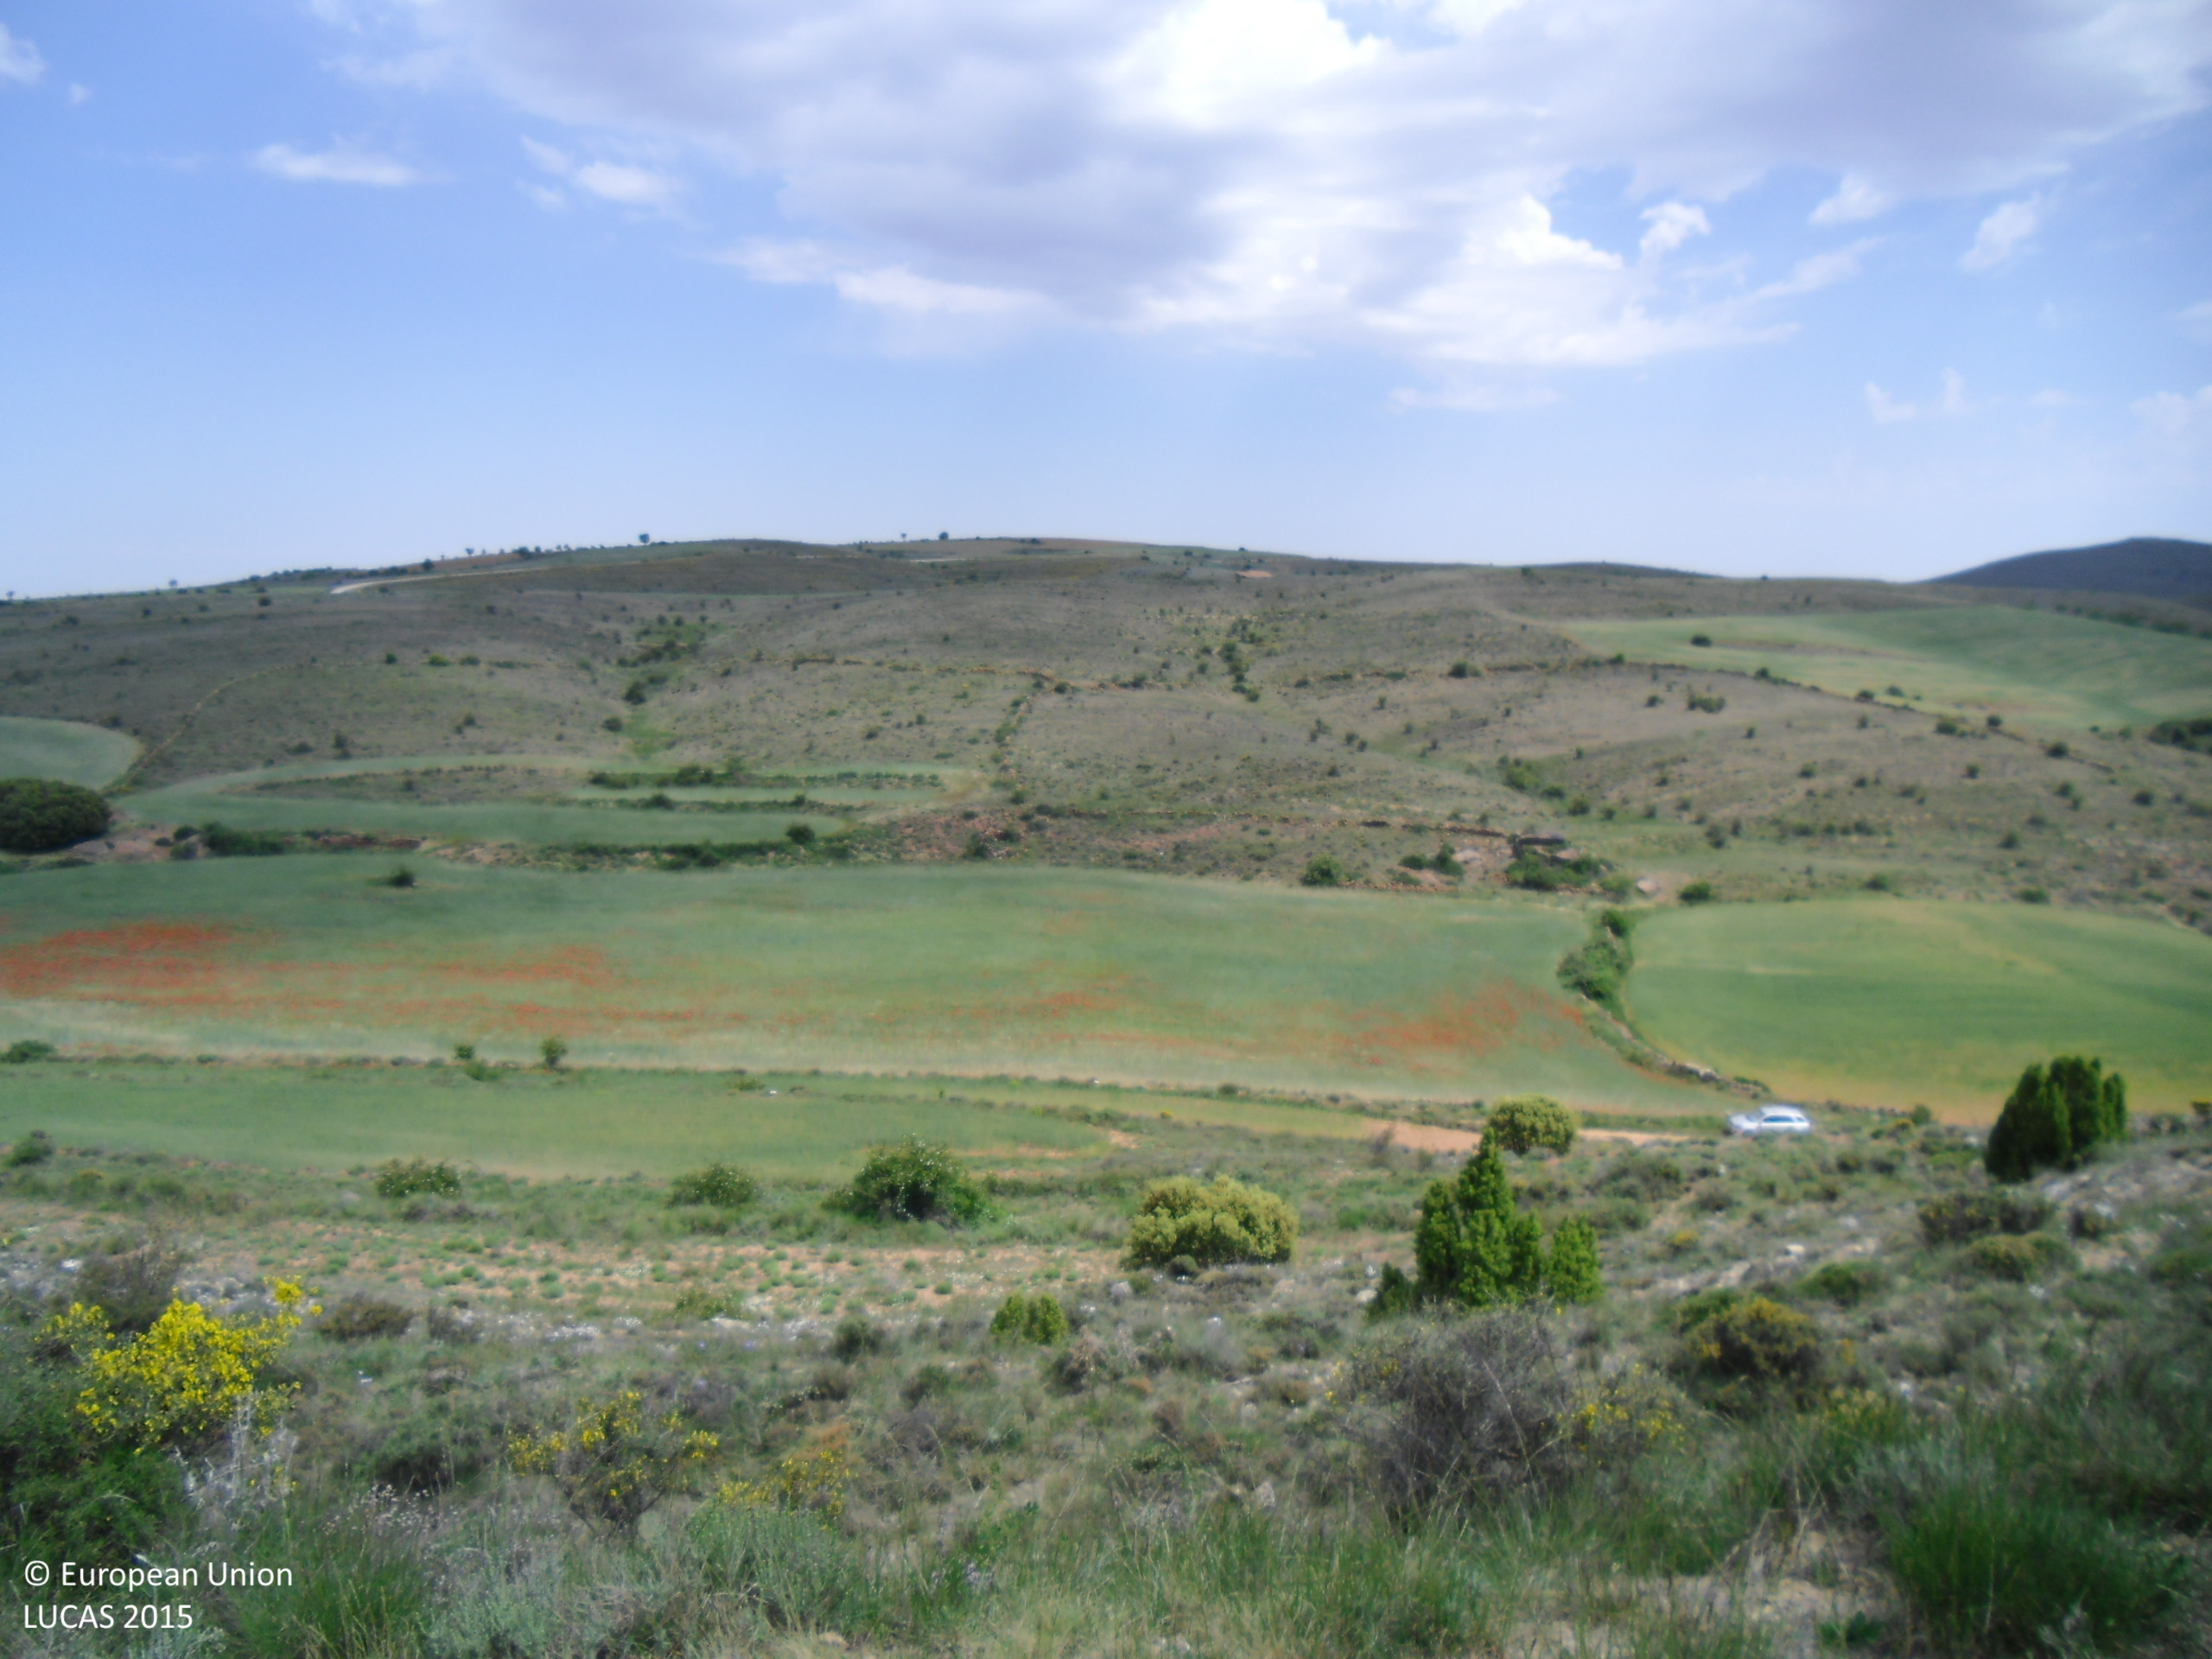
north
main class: Shrubland
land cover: Shrubland without tree cover
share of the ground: > 75 %
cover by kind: shrubs 80 %, herbaceous plants 20 %
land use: Agriculture (excluding fallow land and kitchen gardens)
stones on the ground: < 10 %
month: May
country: ES
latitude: 40.8828
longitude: -0.8732
